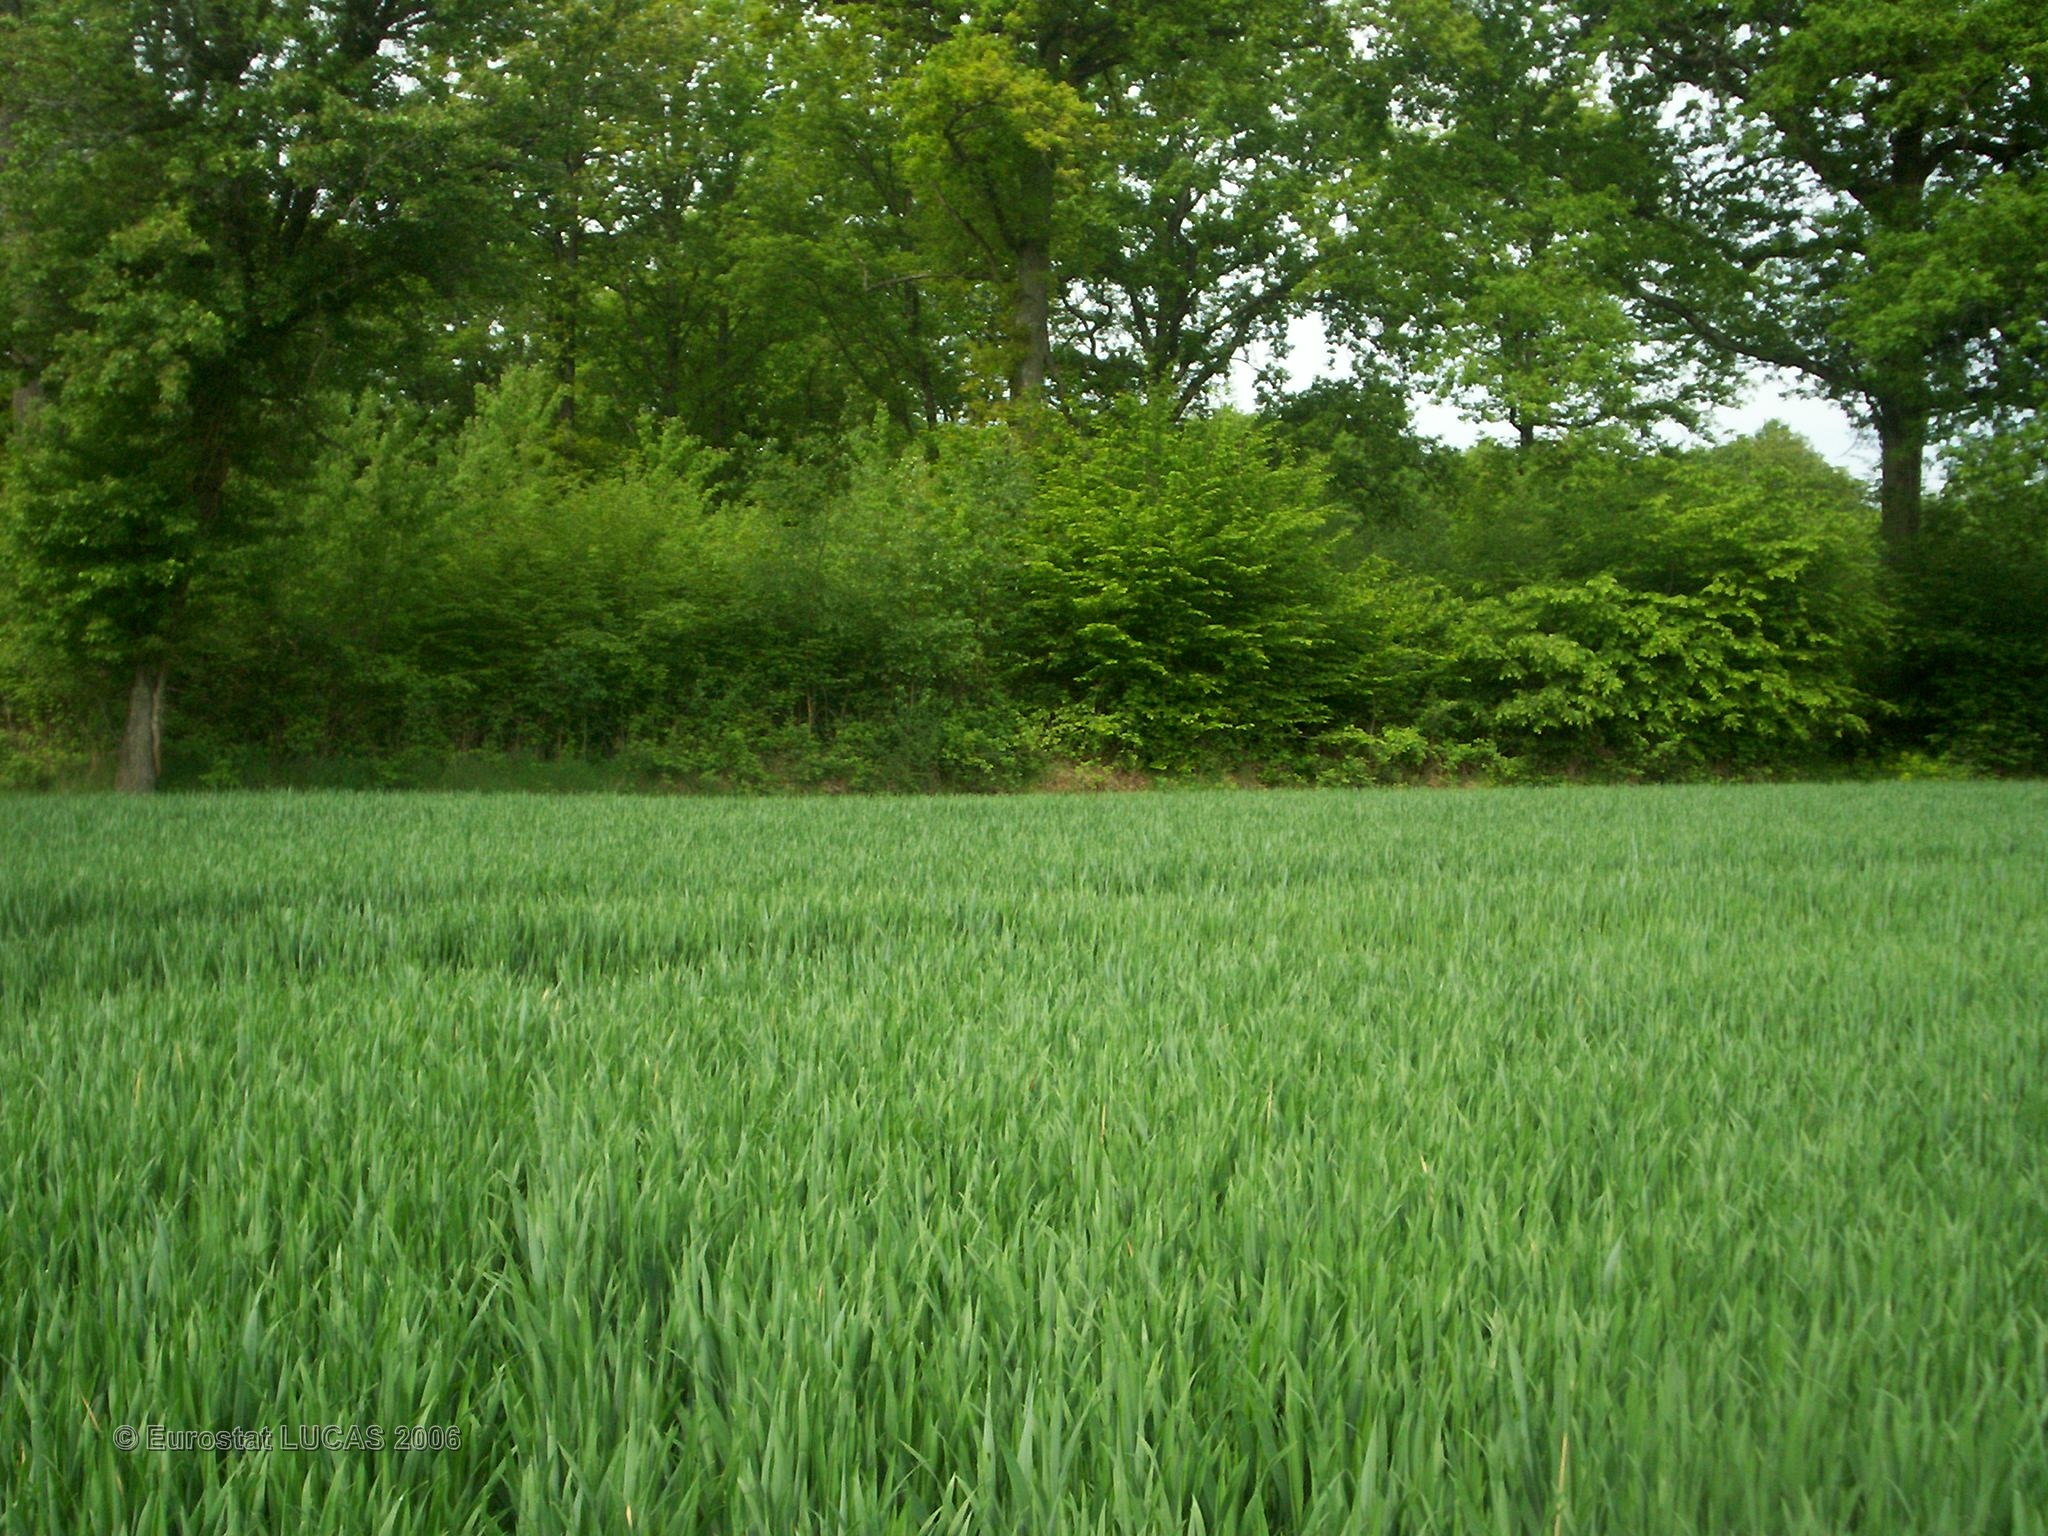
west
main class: Cropland
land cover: Barley
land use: Agriculture (excluding fallow land and kitchen gardens)
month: May
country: FR
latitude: 47.7475
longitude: 2.9912
